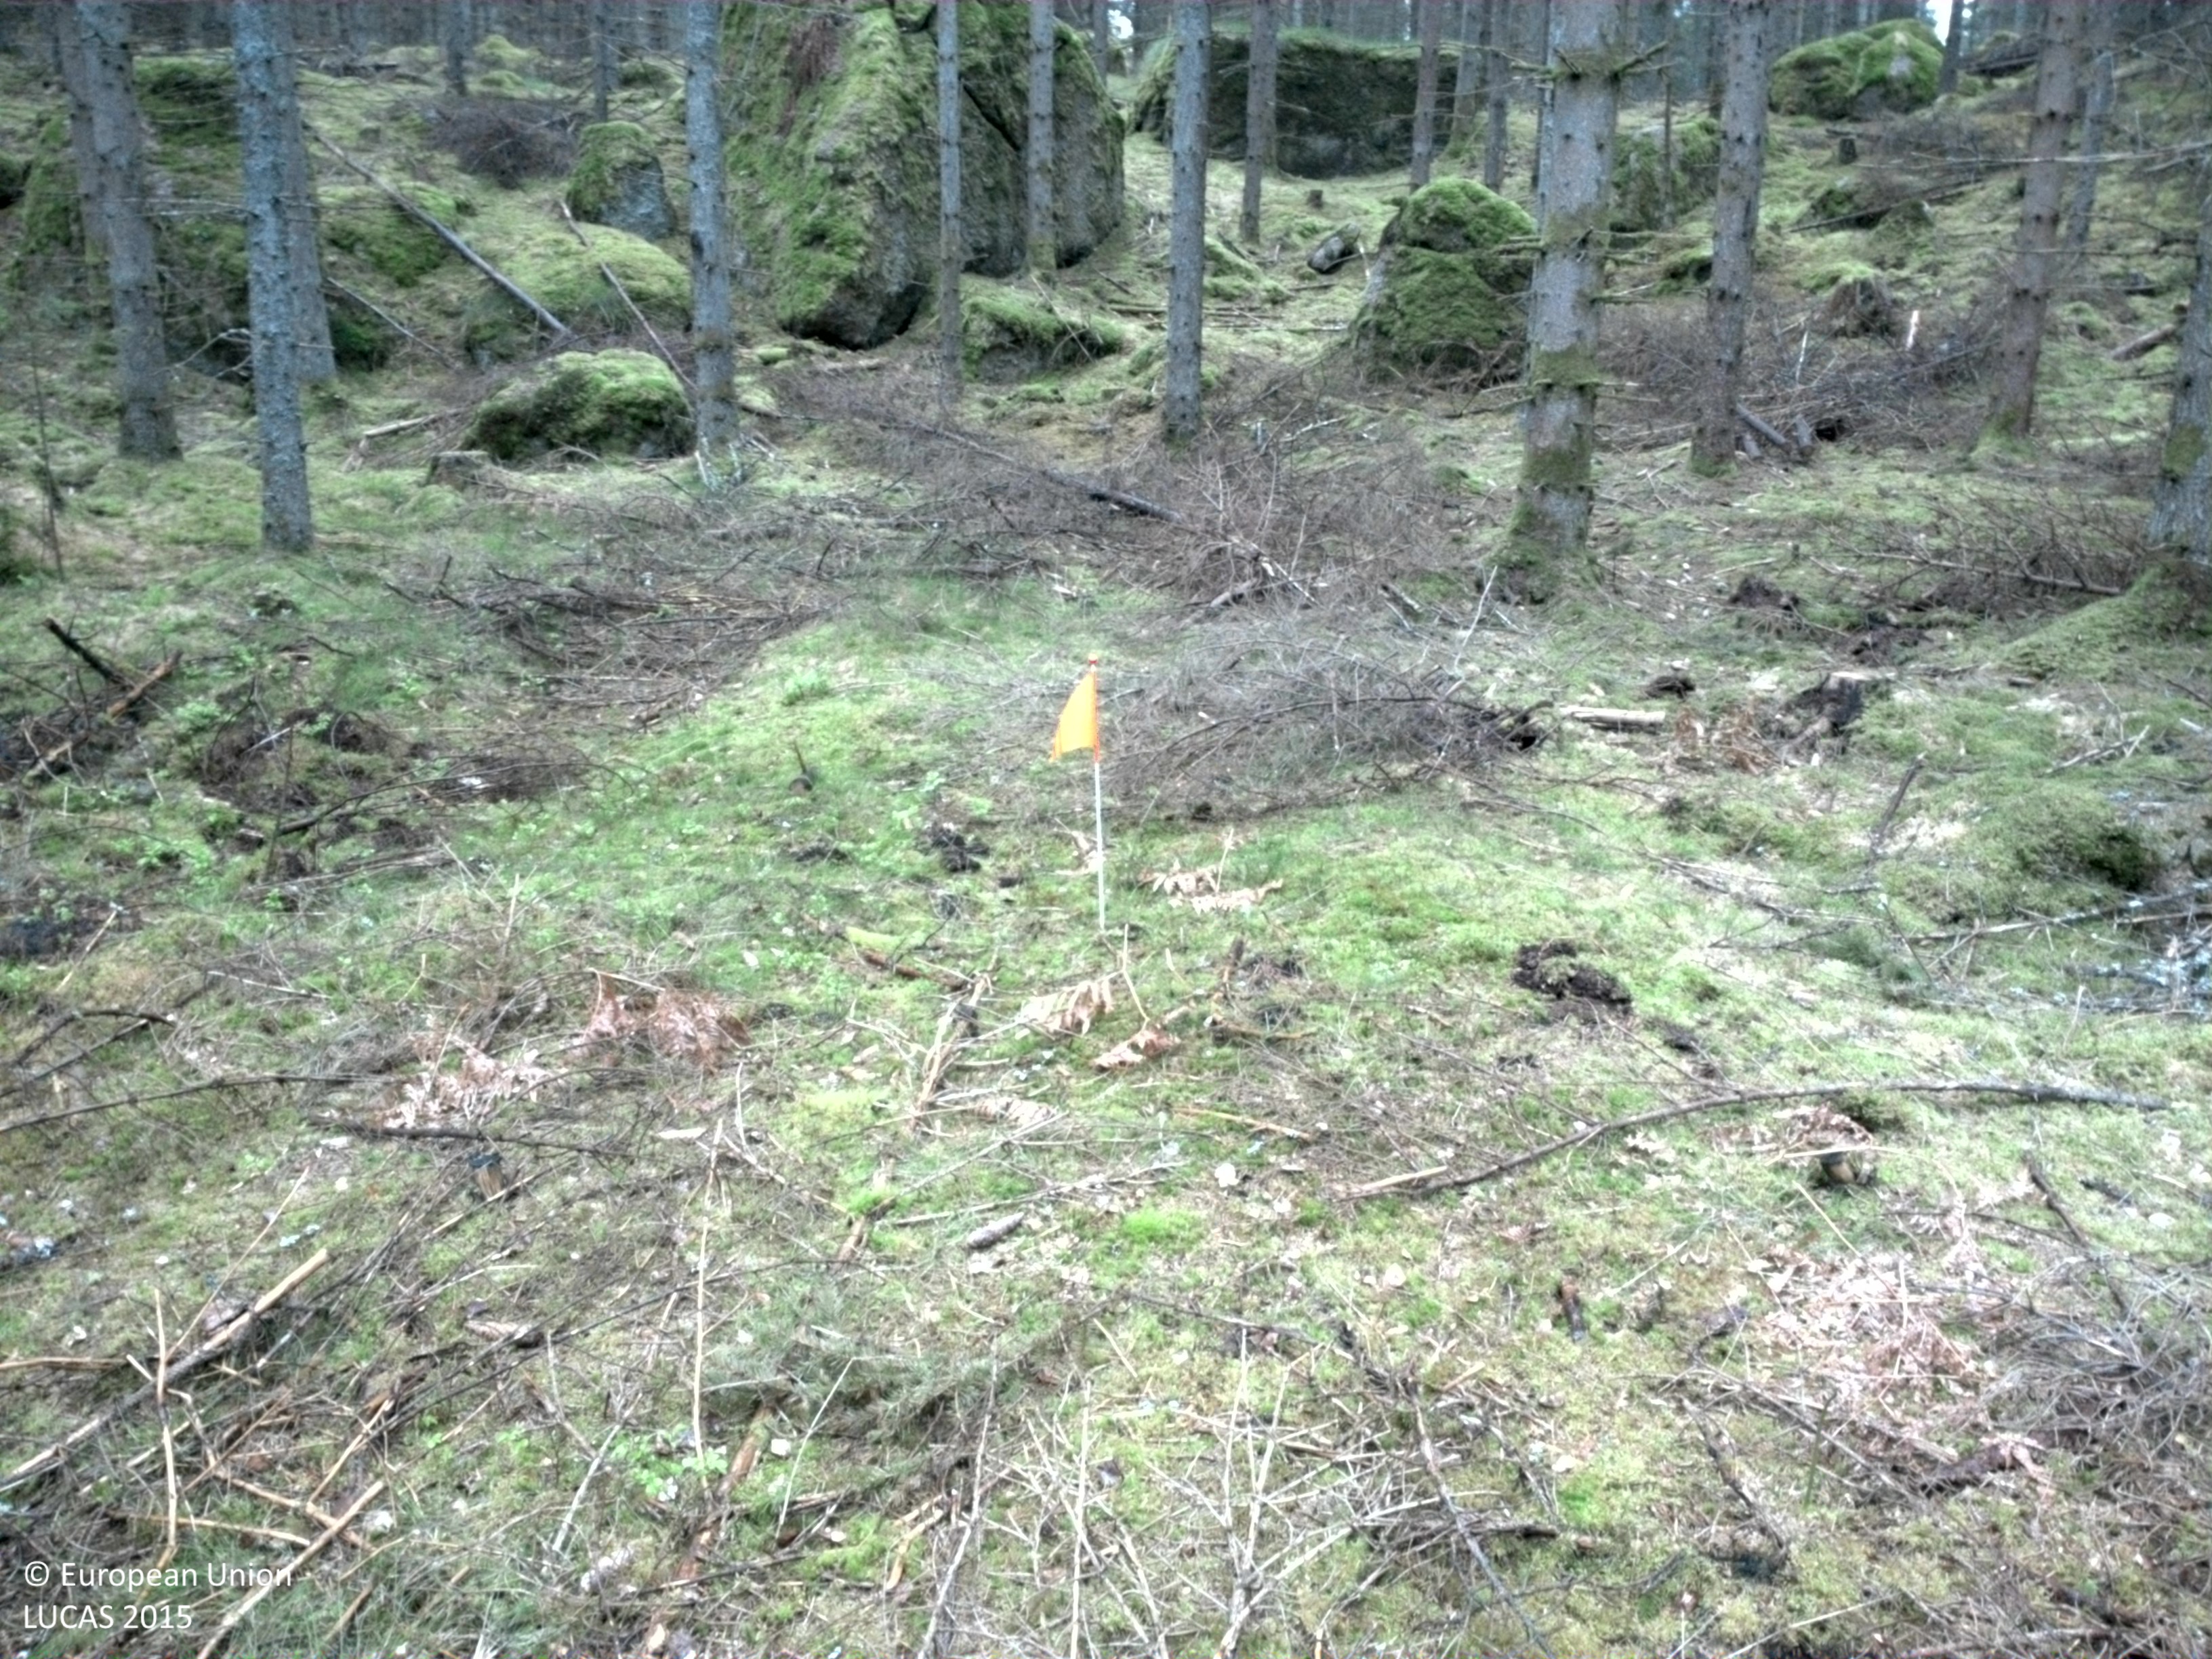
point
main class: Woodland
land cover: Spruce dominated coniferous woodland
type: boreal forest
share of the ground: > 75 %
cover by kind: coniferous forest trees 95 %, lichens and mosses 5 %
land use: Forestry
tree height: > 5 m
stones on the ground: 10 - 25 %
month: May
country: SE
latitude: 56.3809
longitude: 15.3918
